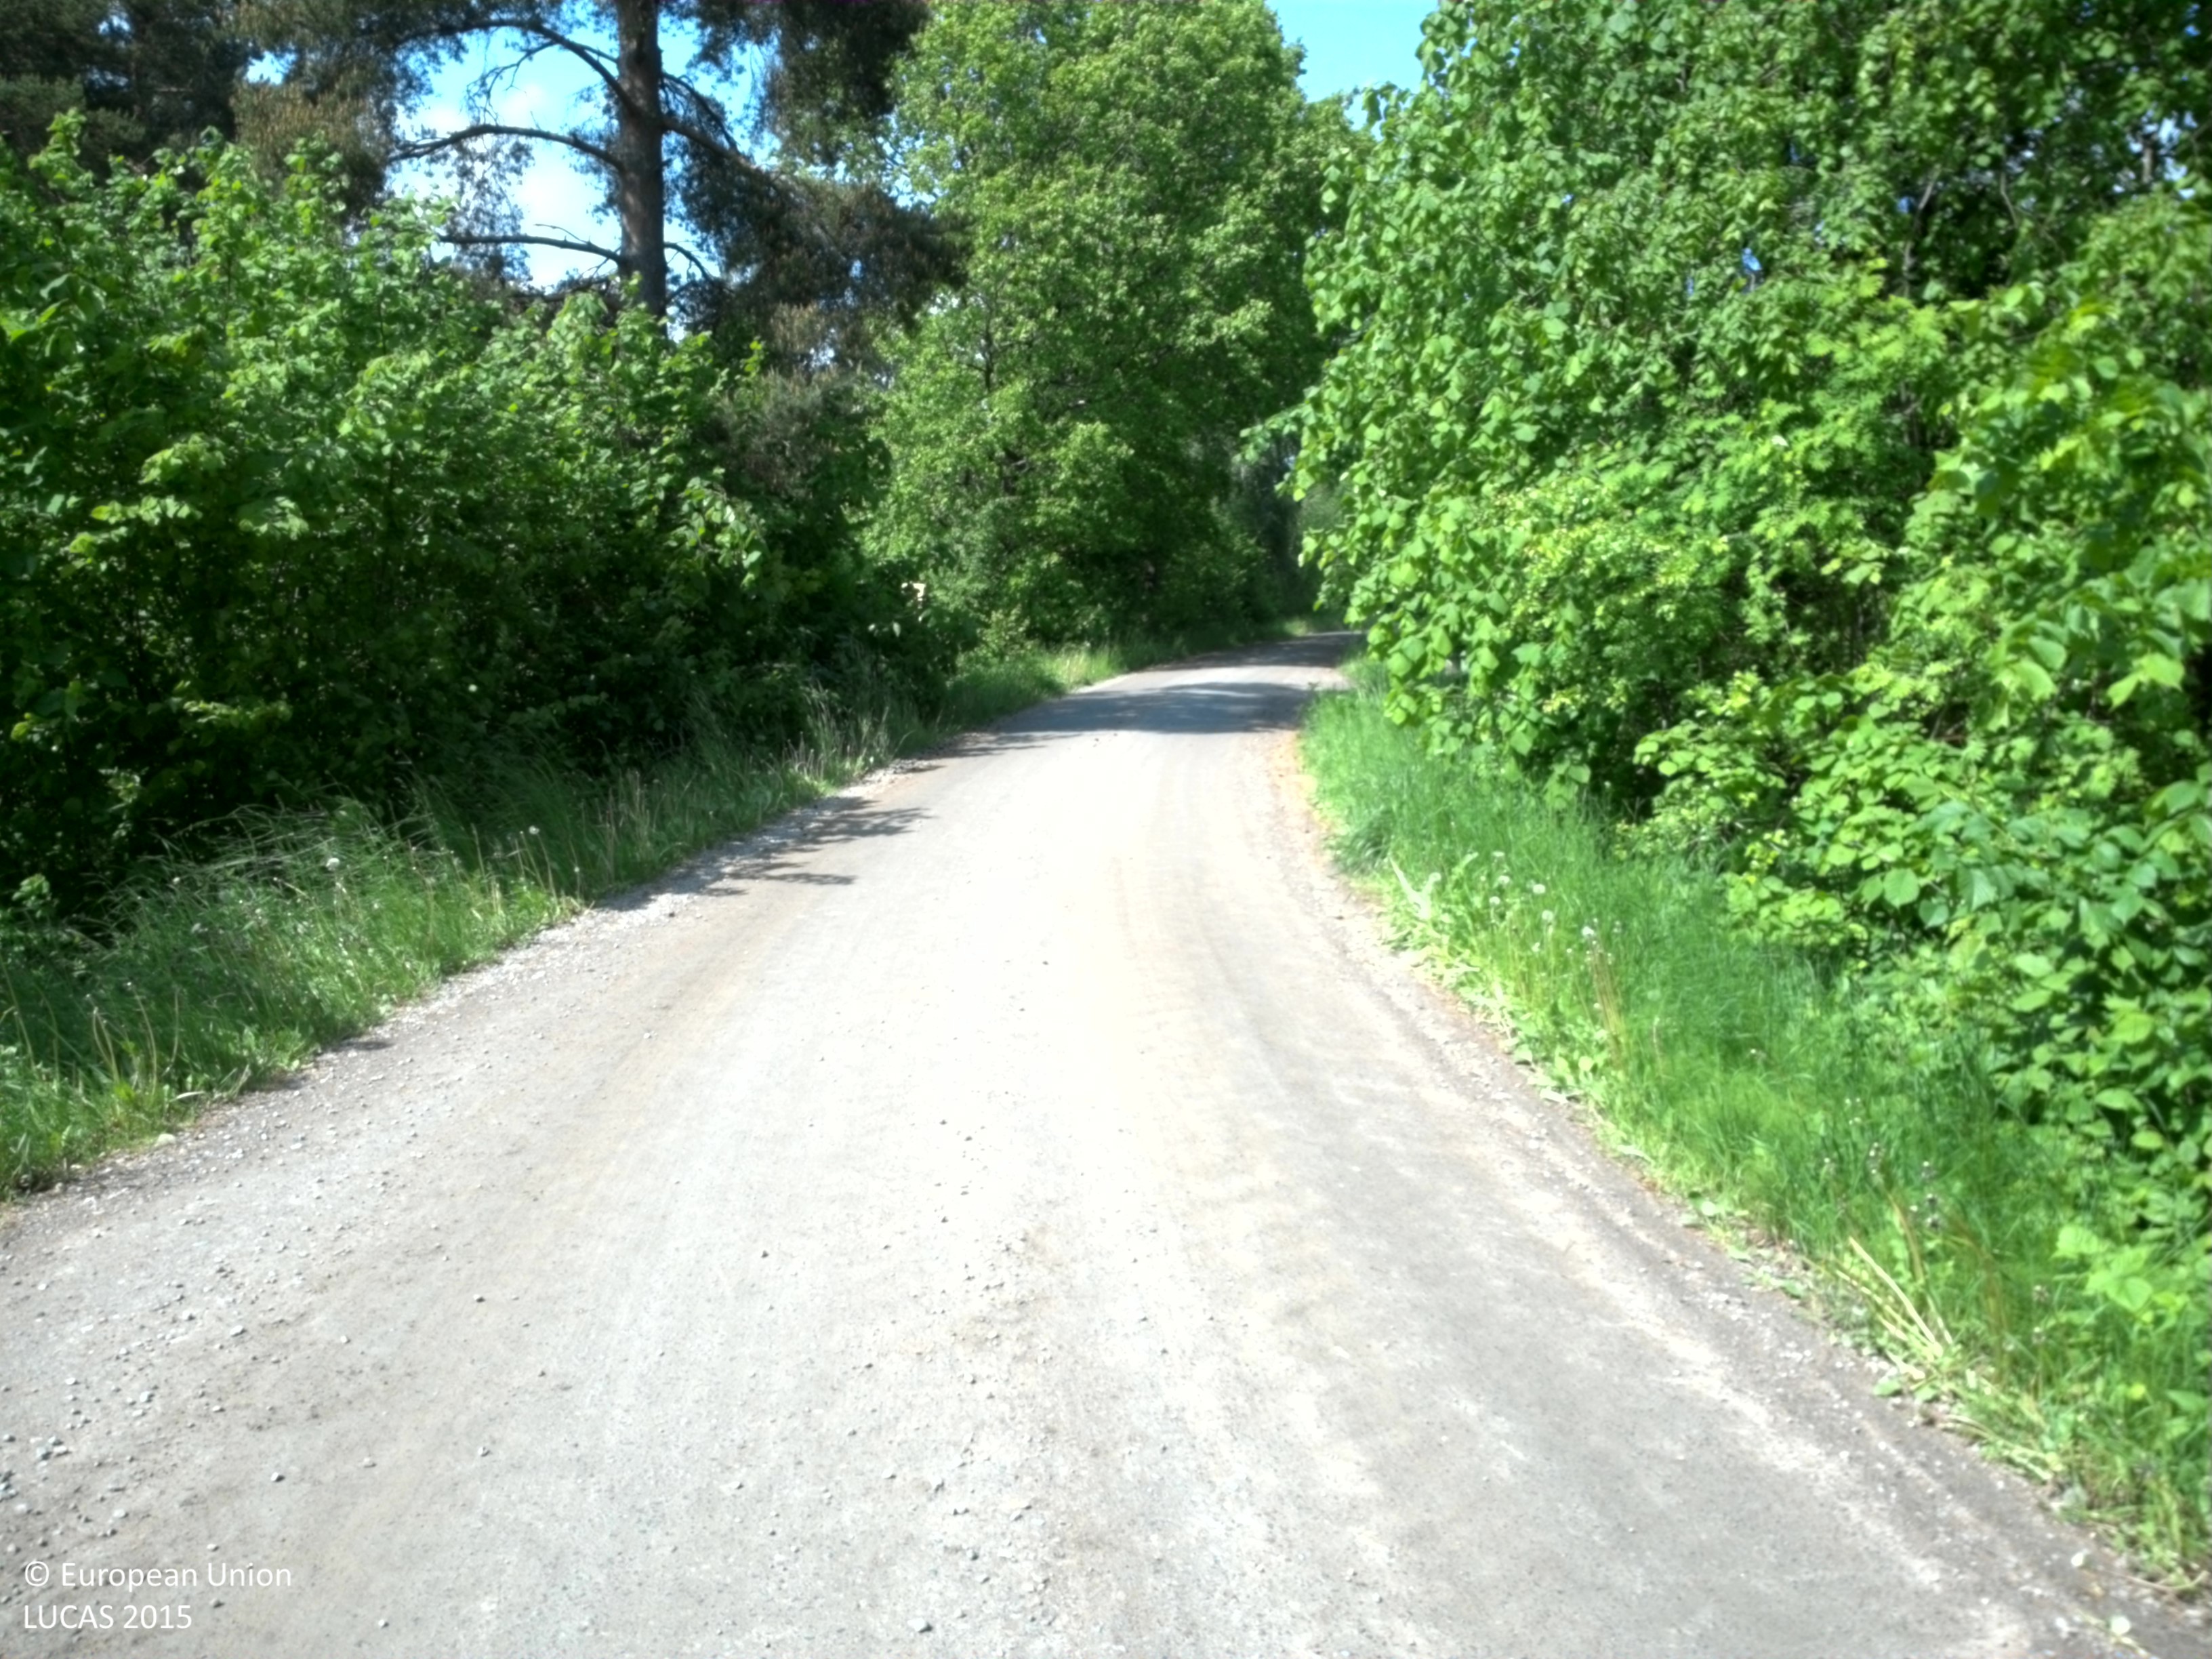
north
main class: Woodland
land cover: Broadleaved woodland
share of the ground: > 75 %
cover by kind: broadleaved forest trees 90 %, herbaceous plants 10 %
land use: Residential
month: June
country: SE
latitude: 58.4871
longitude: 15.4659
